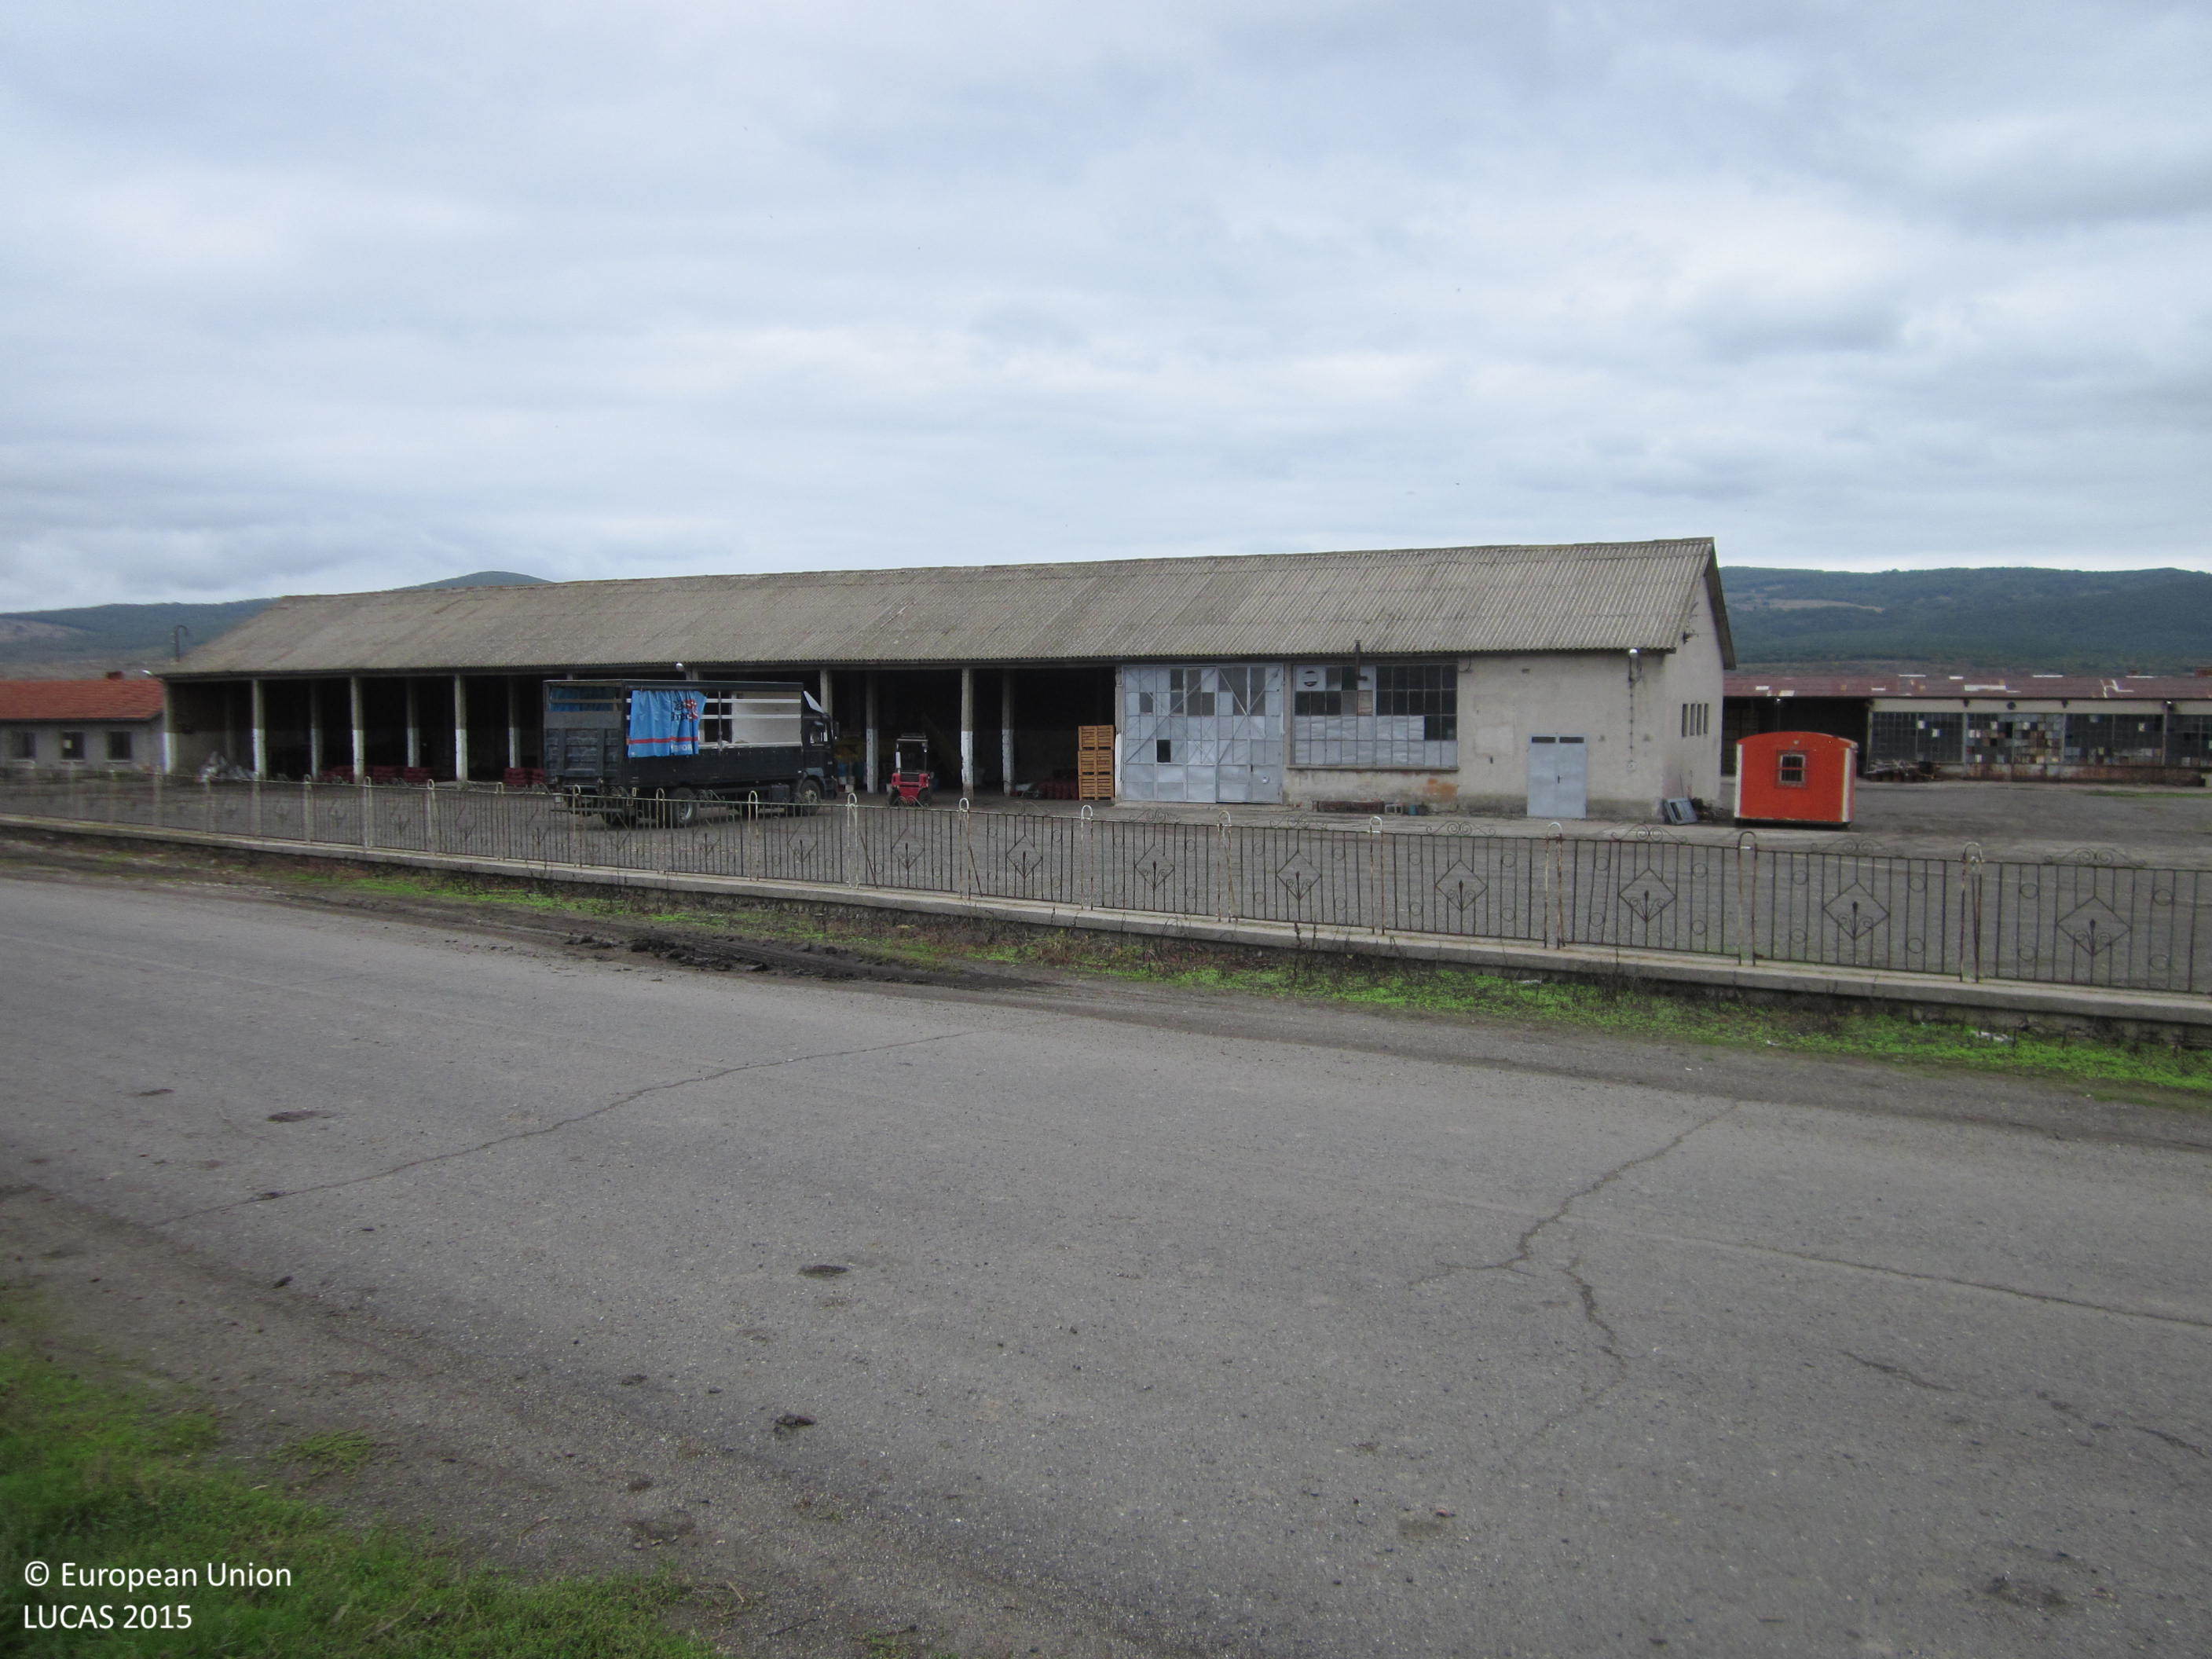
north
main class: Grassland
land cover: Spontaneously vegetated surfaces
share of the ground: > 75 %
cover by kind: herbaceous plants 100 %
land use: Fallow land
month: October
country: BG
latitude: 42.7165
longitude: 27.0951
